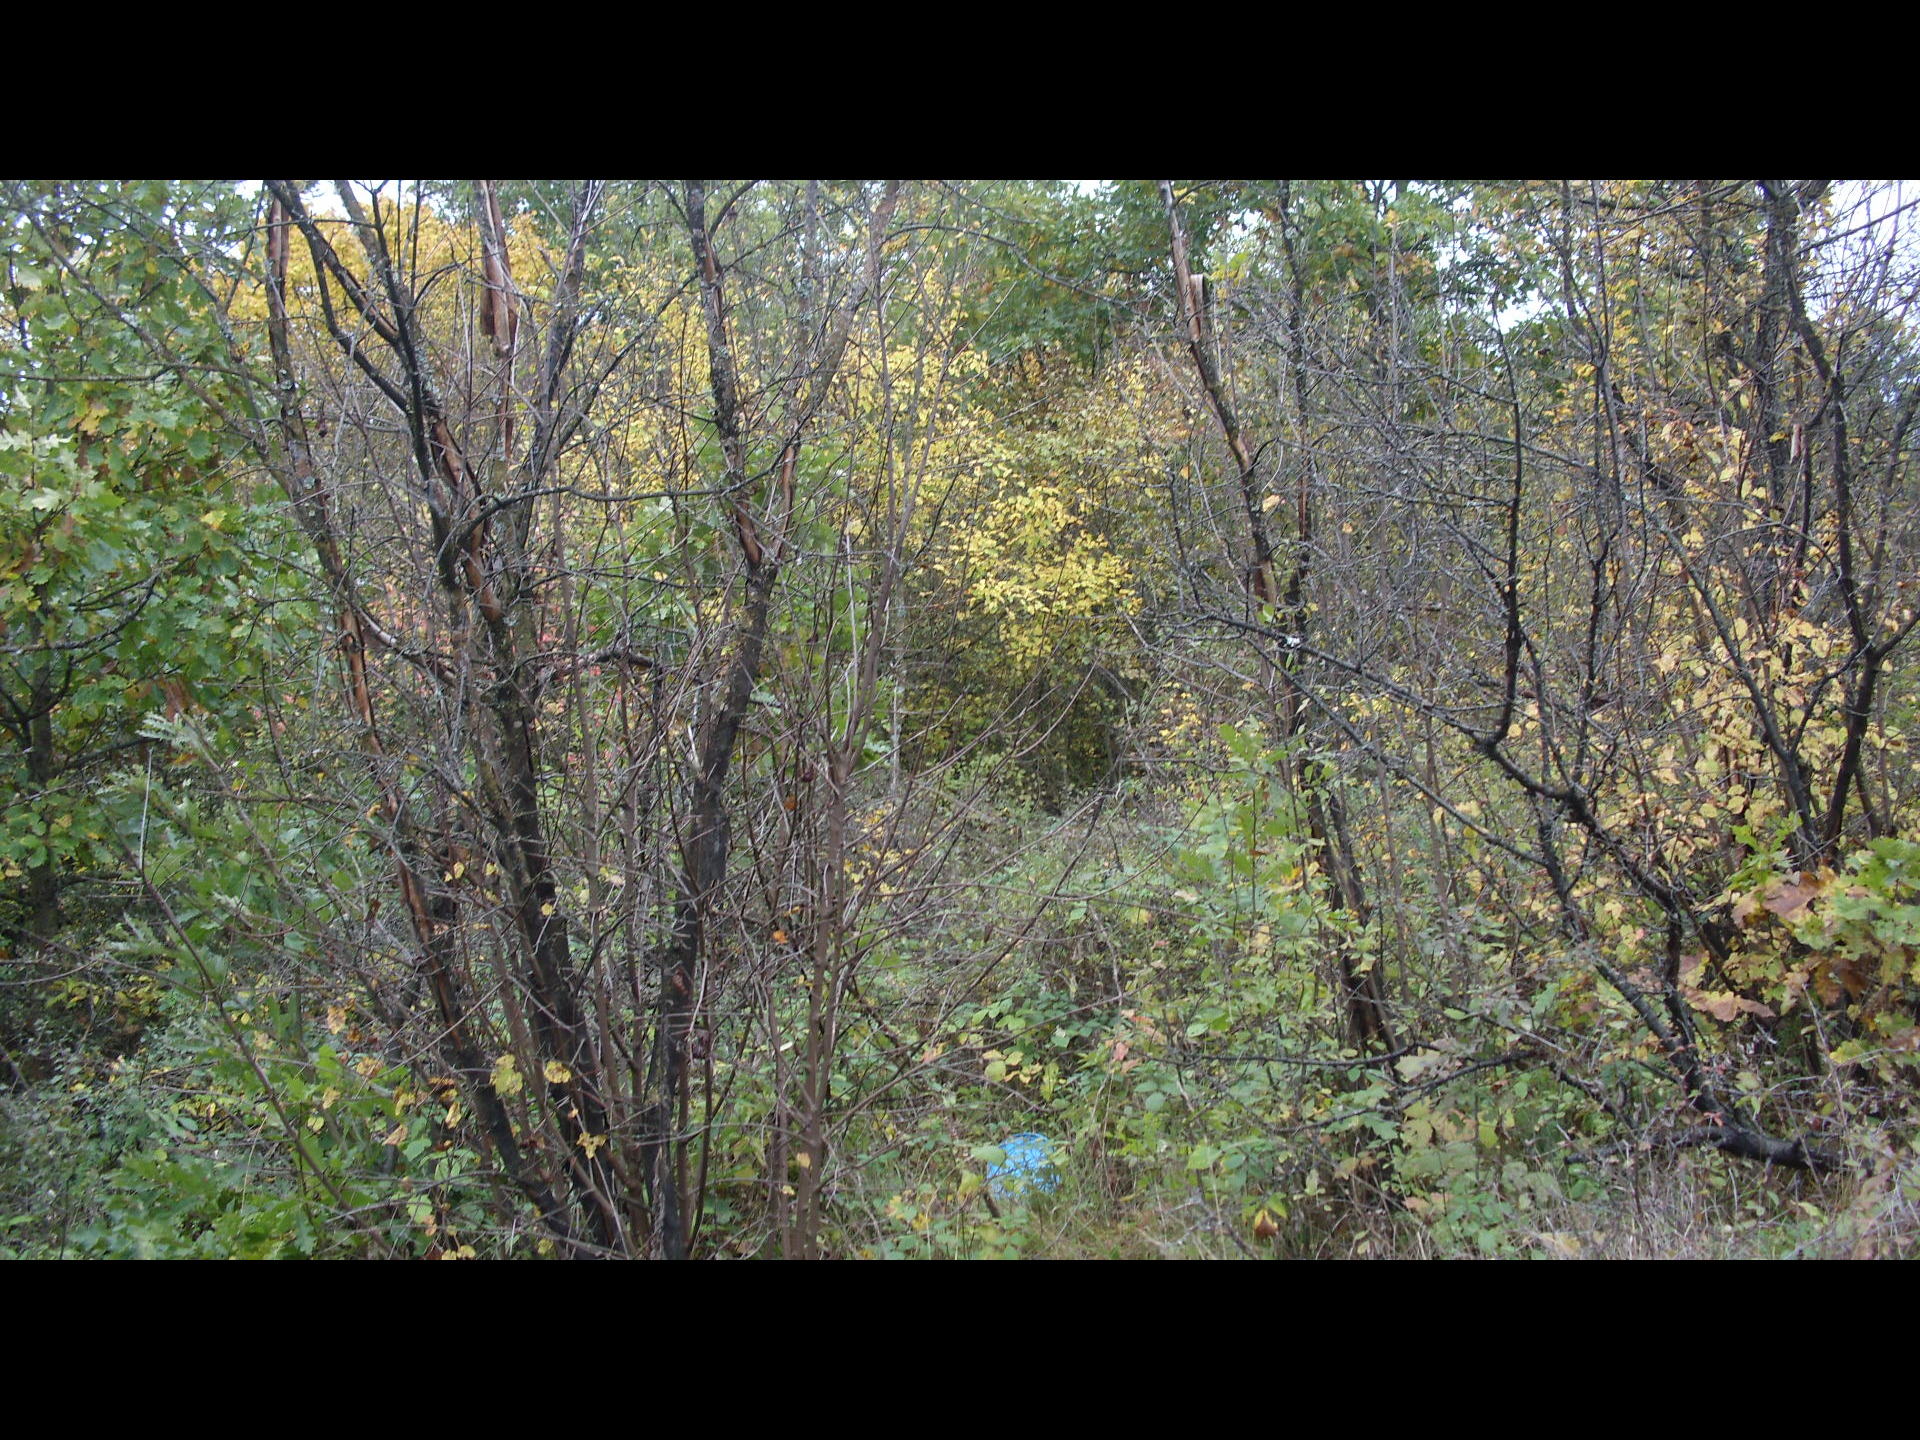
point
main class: Shrubland
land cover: Shrubland with sparse tree cover
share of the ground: > 75 %
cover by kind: shrubs 85 %, herbaceous plants 10 %, broadleaved forest trees 5 %
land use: Semi-natural and natural areas not in use
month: October
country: BG
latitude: 43.6707
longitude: 22.5968
